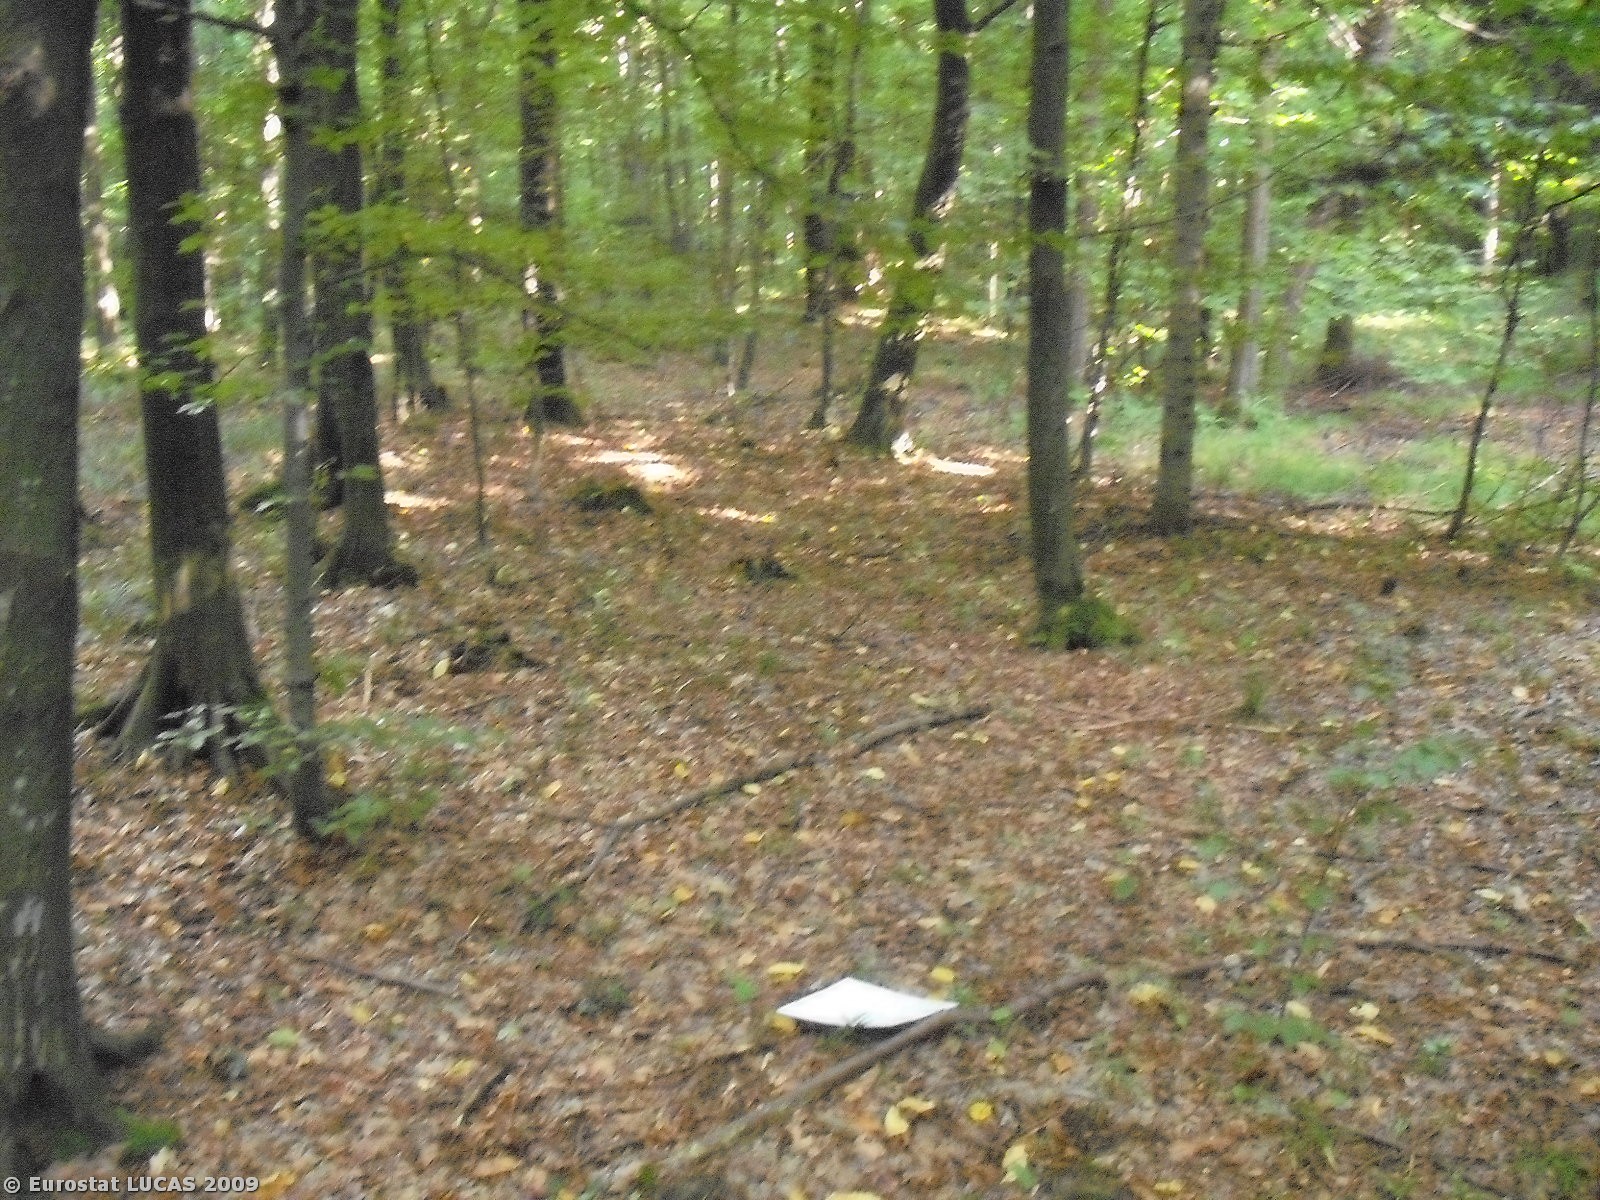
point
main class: Woodland
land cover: Broadleaved woodland
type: mesophytic deciduous forest
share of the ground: > 75 %
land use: Forestry
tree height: > 5 m
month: September
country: PL
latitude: 49.9241
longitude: 22.0510
